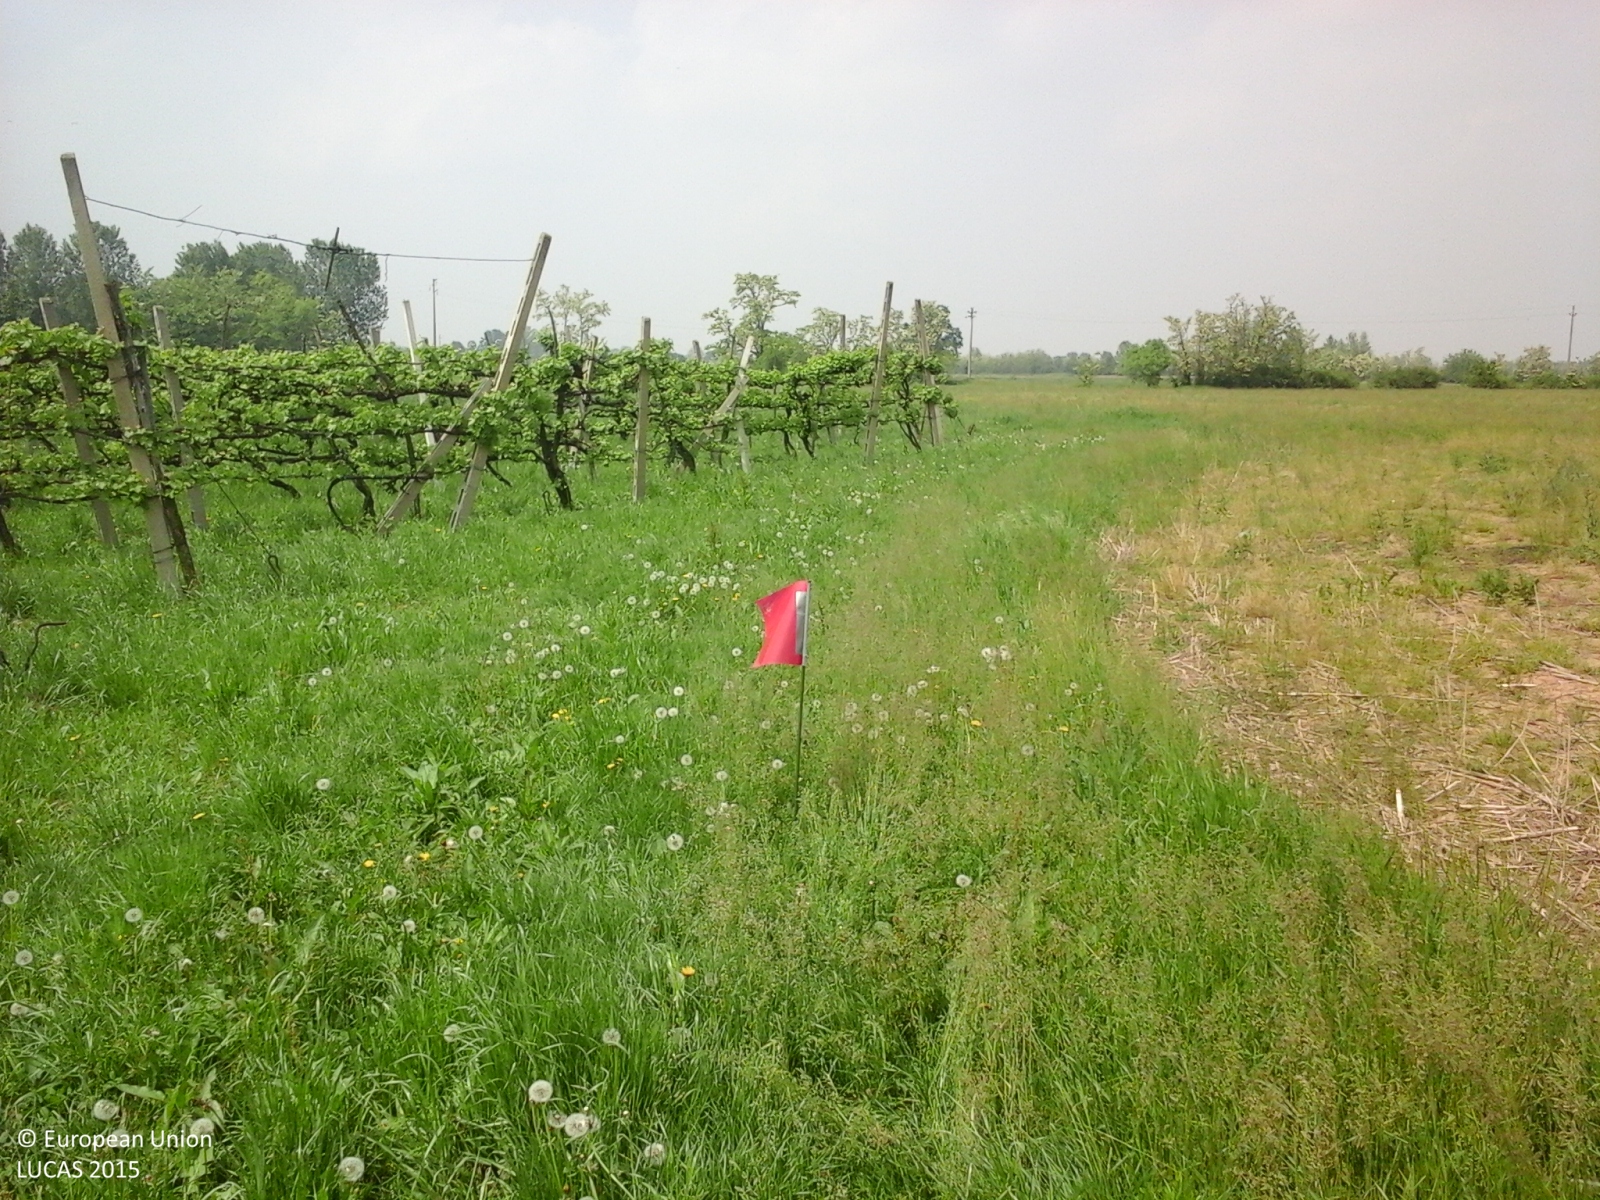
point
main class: Grassland
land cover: Grassland without tree/shrub cover
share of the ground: > 75 %
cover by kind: herbaceous plants 100 %
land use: Agriculture (excluding fallow land and kitchen gardens)
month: May
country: IT
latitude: 45.2156
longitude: 10.2923
